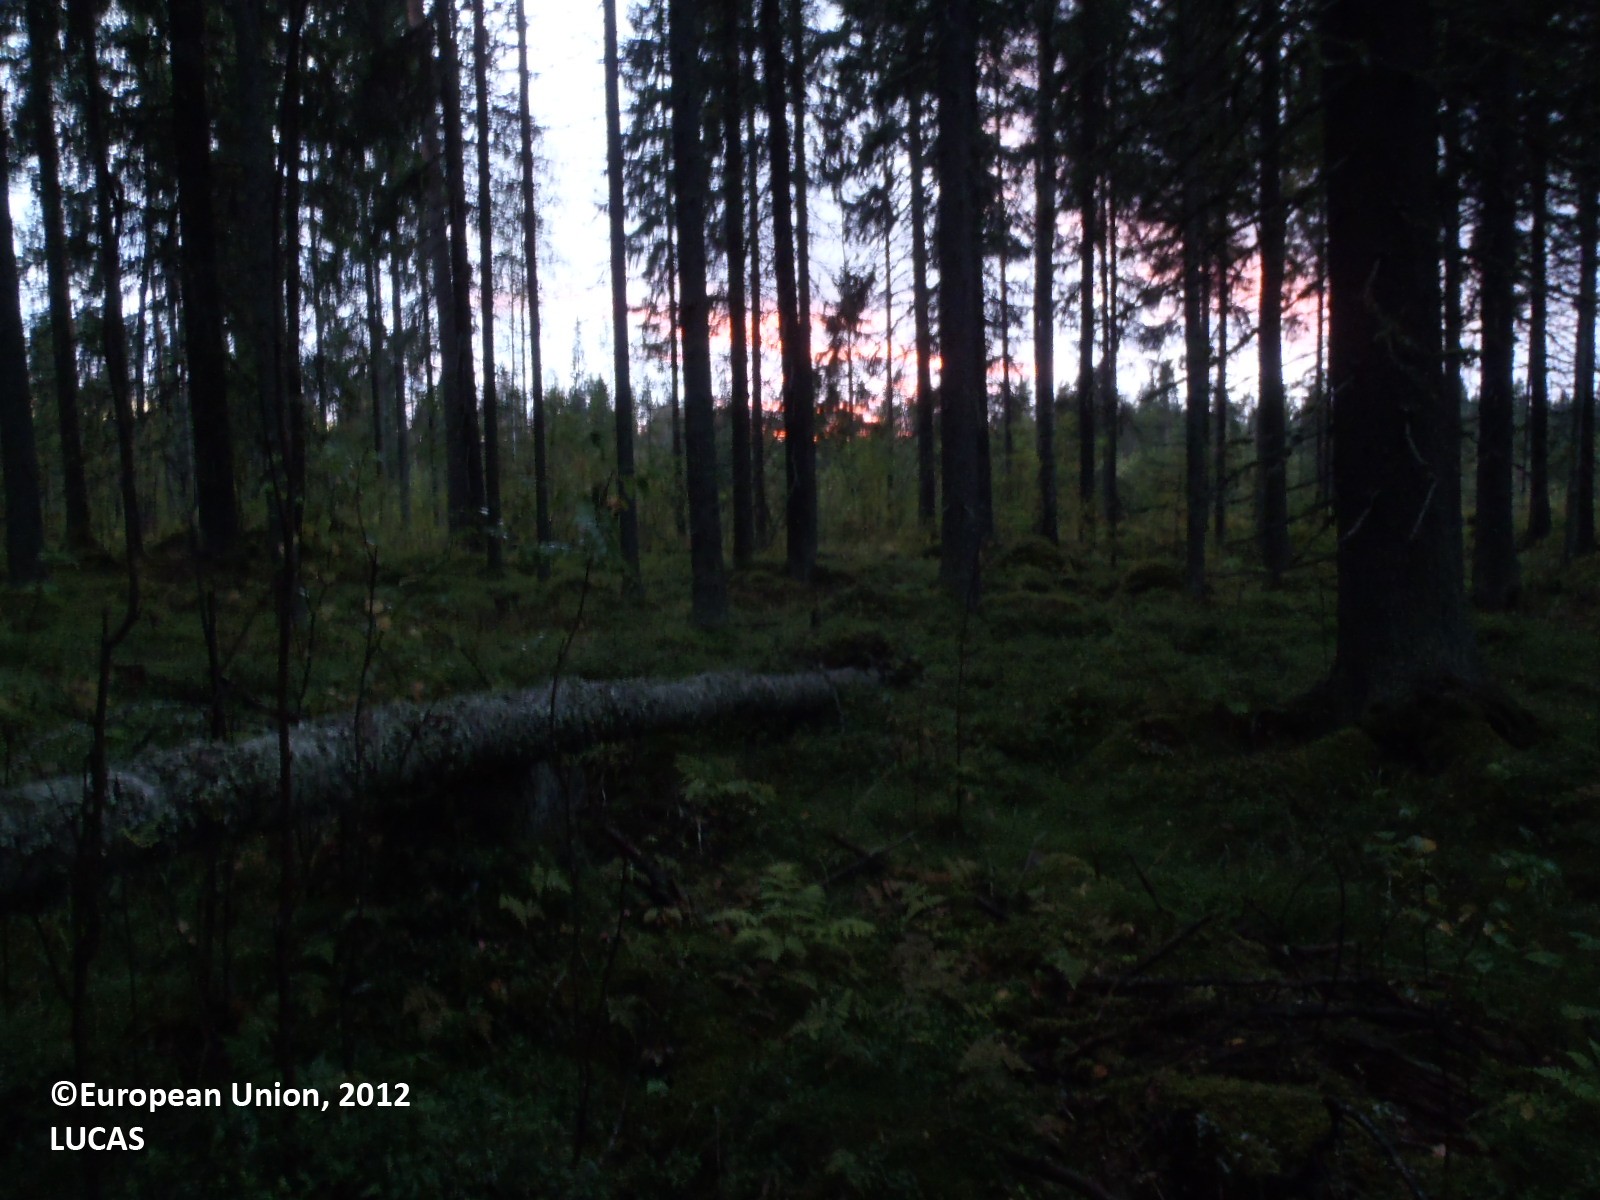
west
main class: Woodland
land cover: Spruce dominated coniferous woodland
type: boreal forest
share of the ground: > 75 %
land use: Forestry
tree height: > 5 m
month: September
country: FI
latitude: 61.7110
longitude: 22.6424
